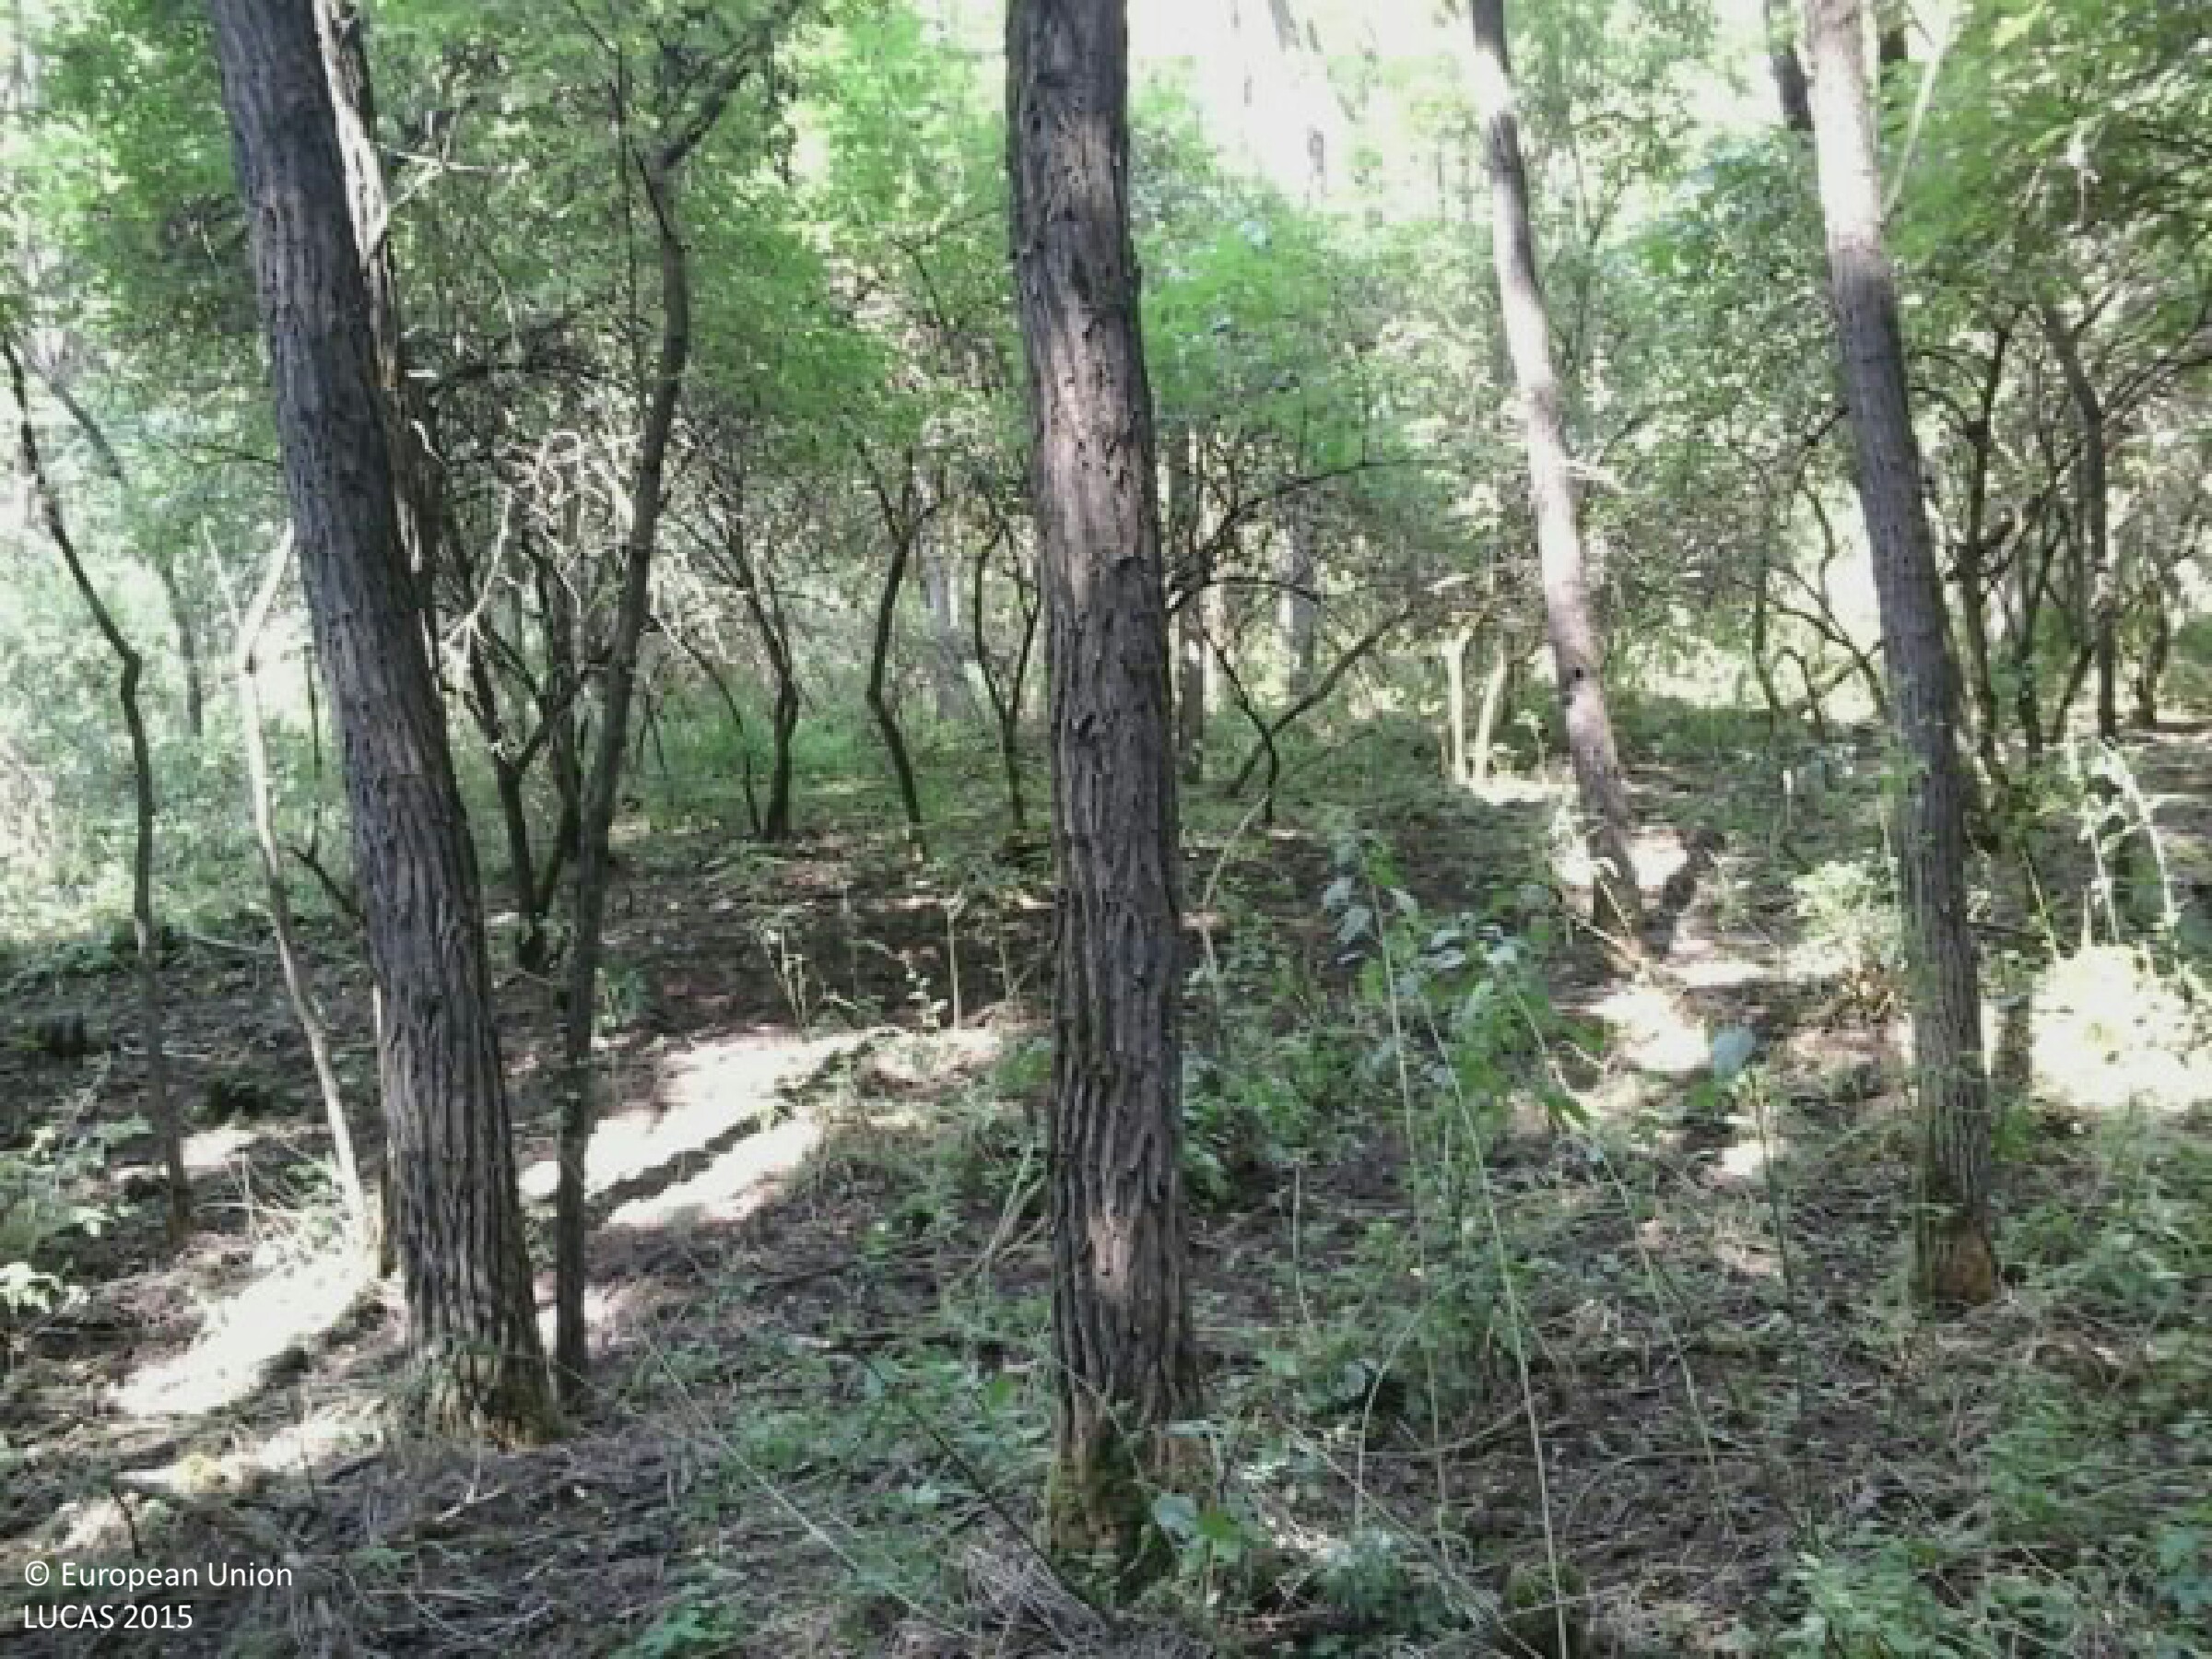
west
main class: Woodland
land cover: Broadleaved woodland
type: mesophytic deciduous forest
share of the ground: > 75 %
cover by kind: broadleaved forest trees 90 %, herbaceous plants 10 %
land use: Forestry
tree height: > 5 m
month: August
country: HU
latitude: 48.0046
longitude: 19.9869
